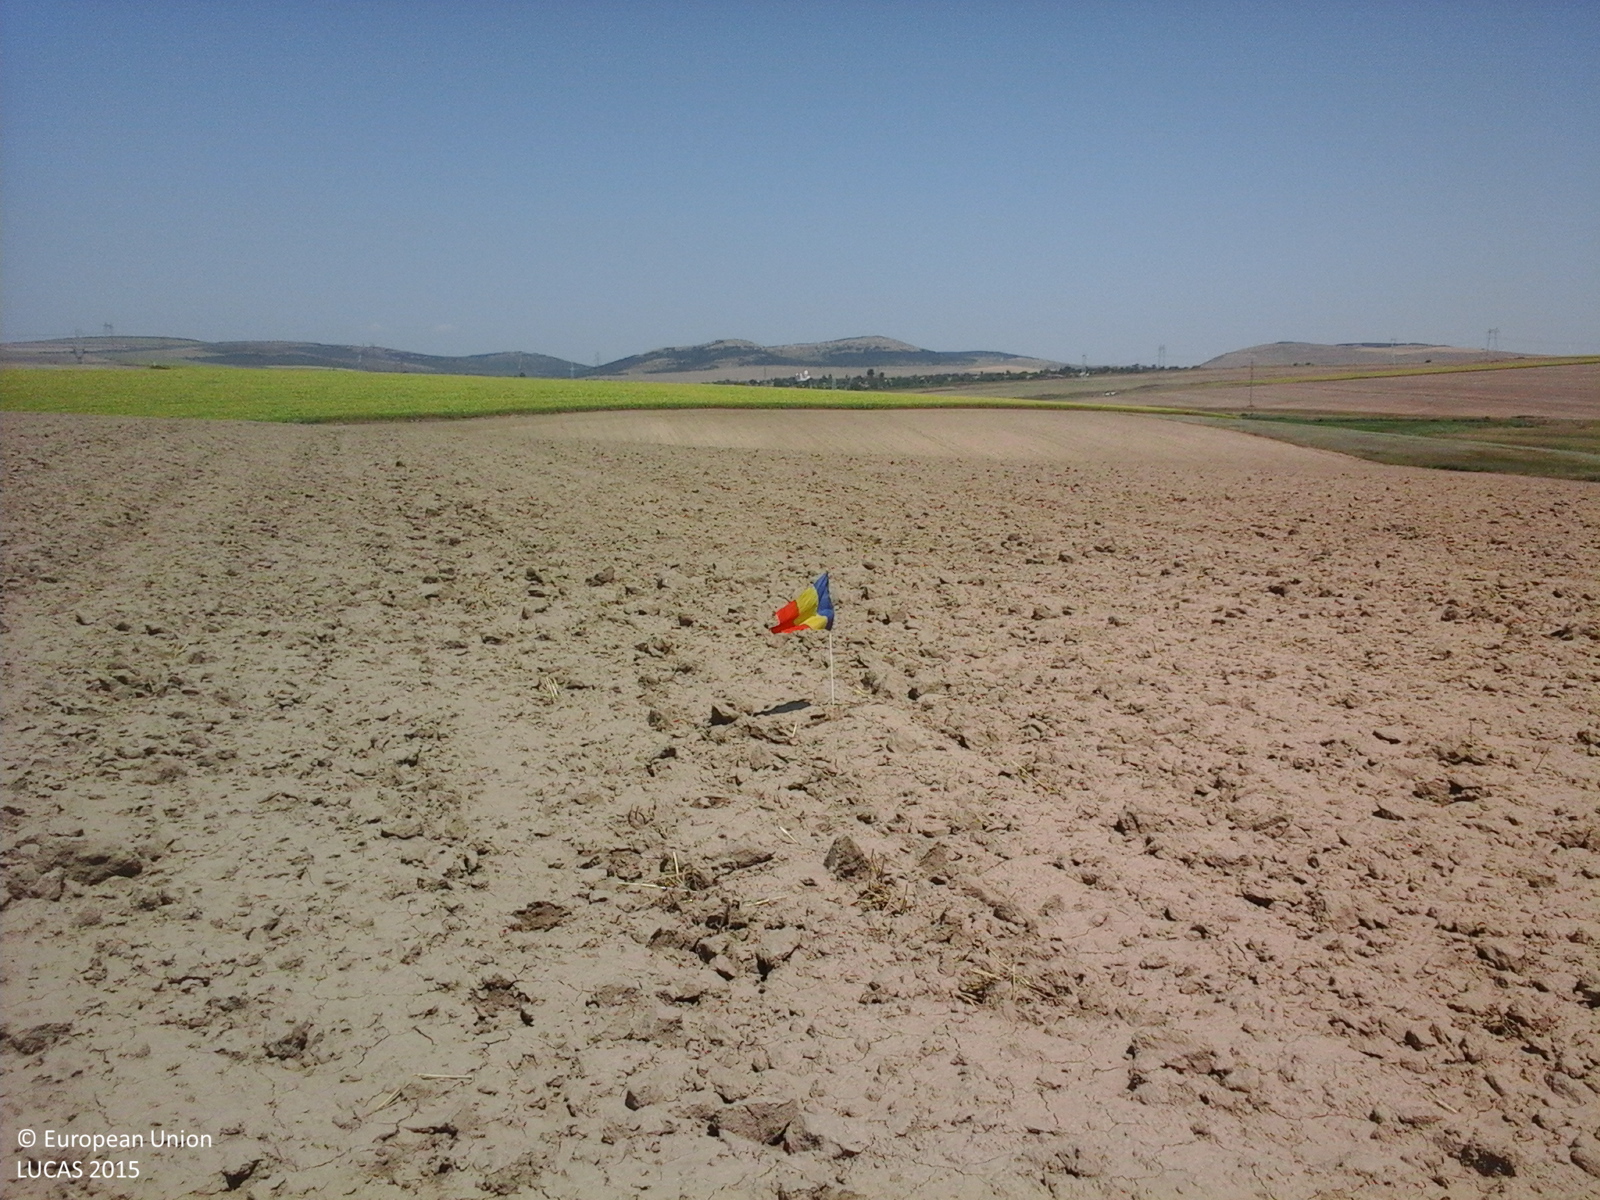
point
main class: Cropland
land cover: Common wheat
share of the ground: < 10 %
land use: Agriculture (excluding fallow land and kitchen gardens)
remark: Harvested field
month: August
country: RO
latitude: 44.4634
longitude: 28.1744
